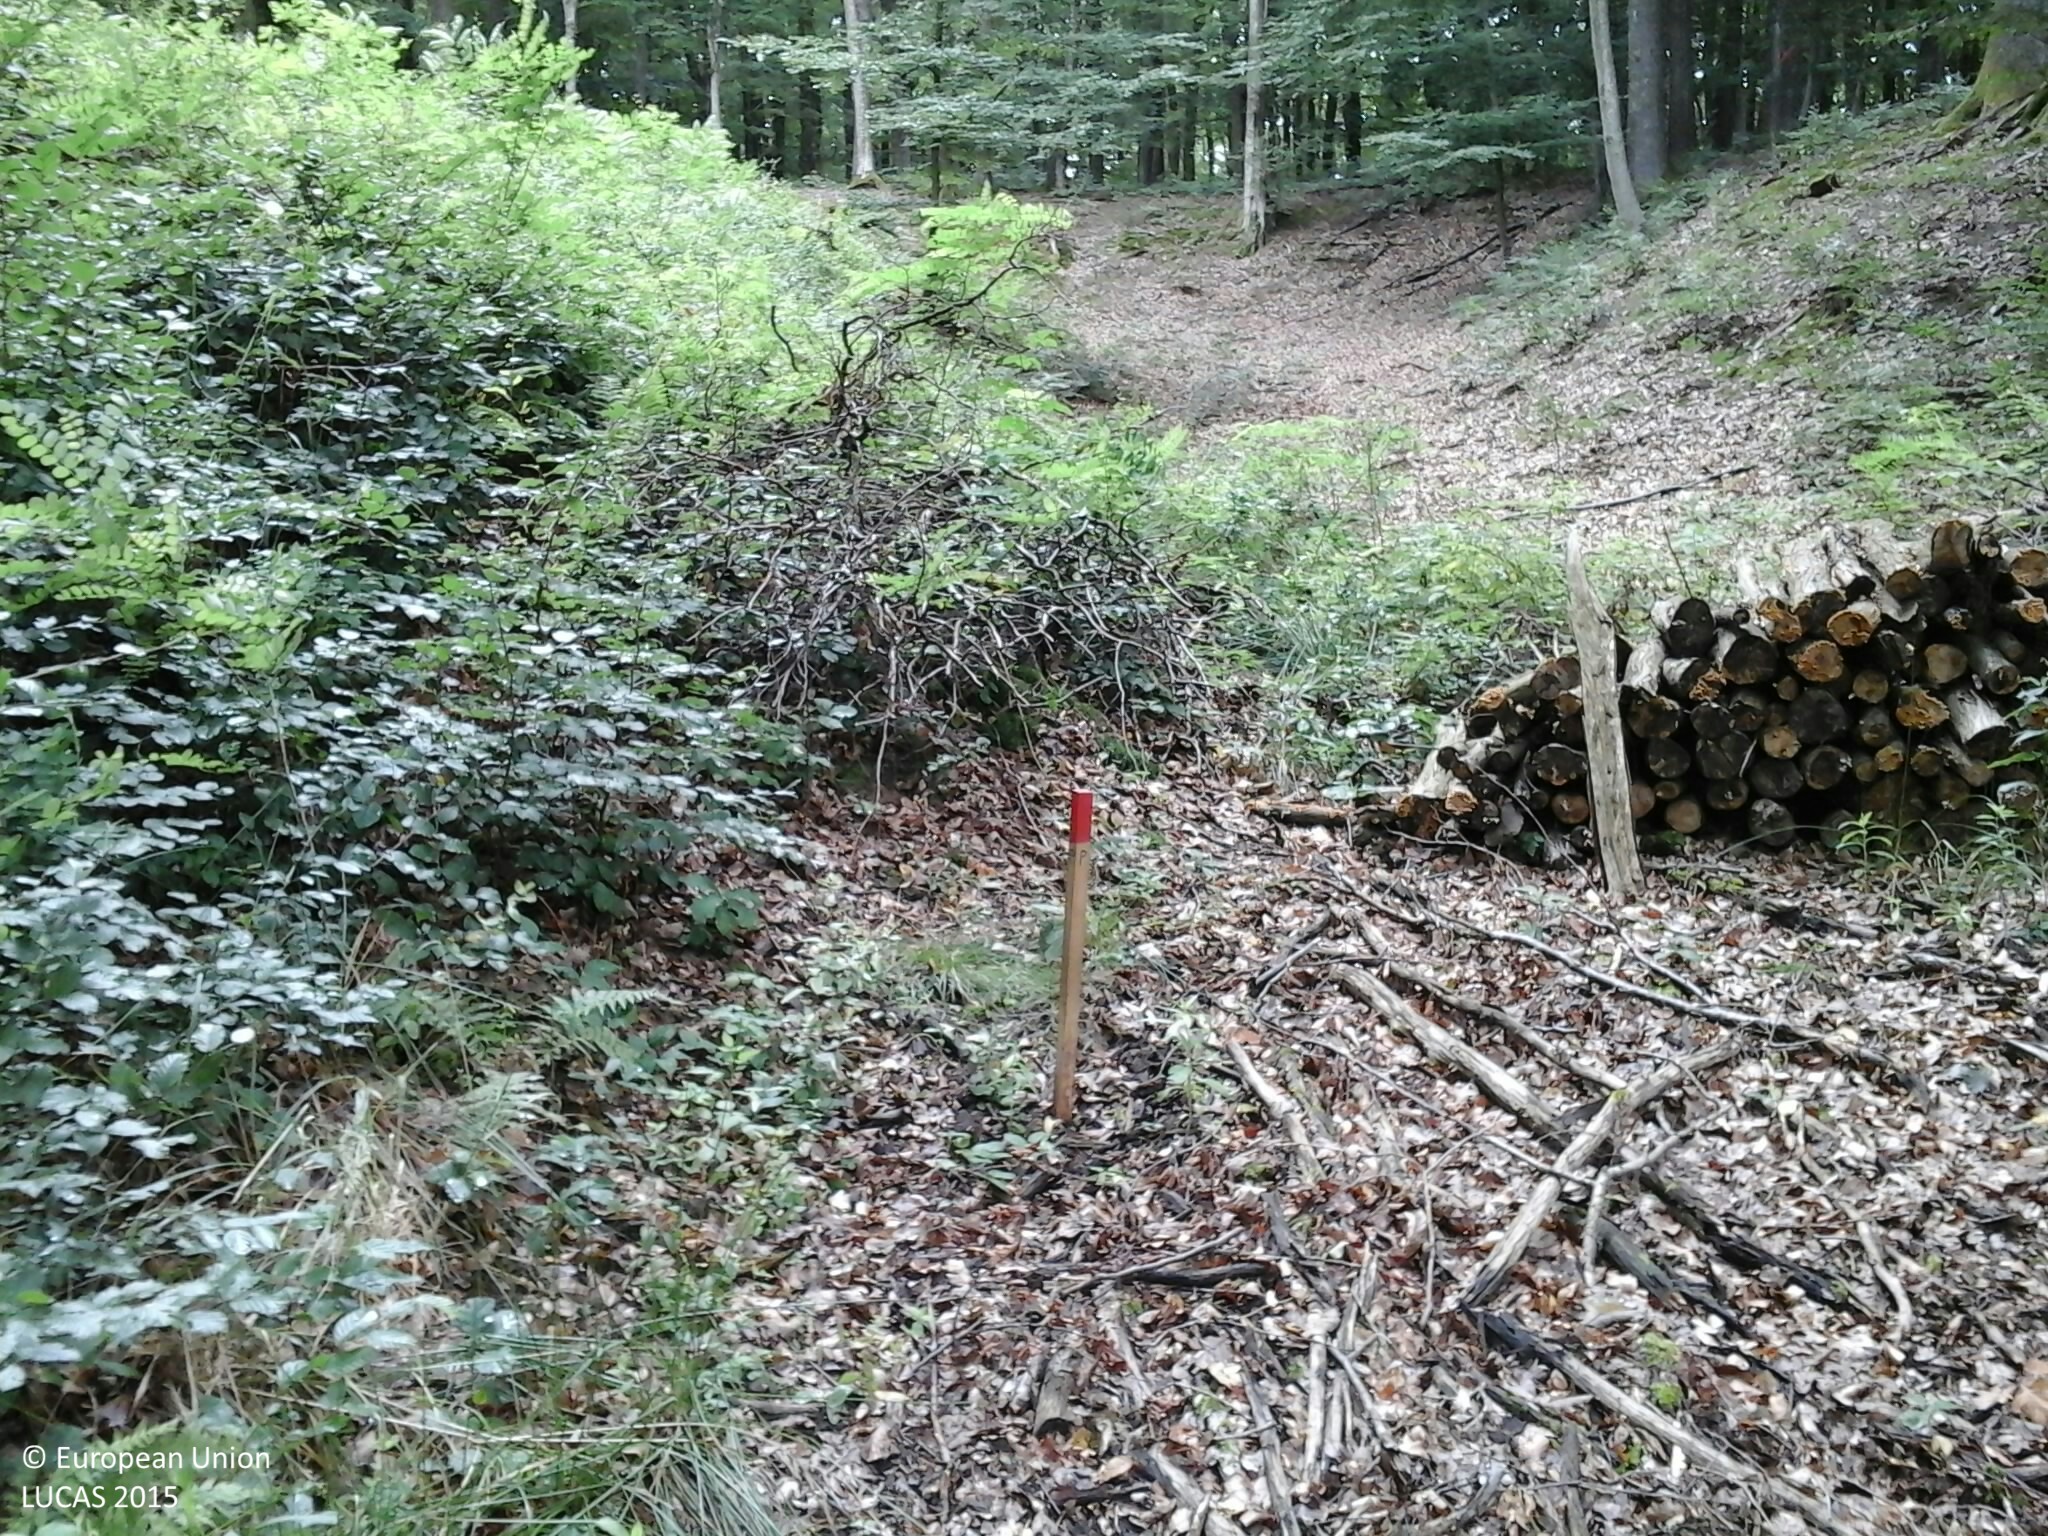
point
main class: Woodland
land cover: Broadleaved woodland
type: beech forest
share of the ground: > 75 %
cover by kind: broadleaved forest trees 85 %, shrubs 10 %, herbaceous plants 5 %
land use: Forestry
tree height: > 5 m
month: July
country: HU
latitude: 46.7733
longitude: 16.4055
